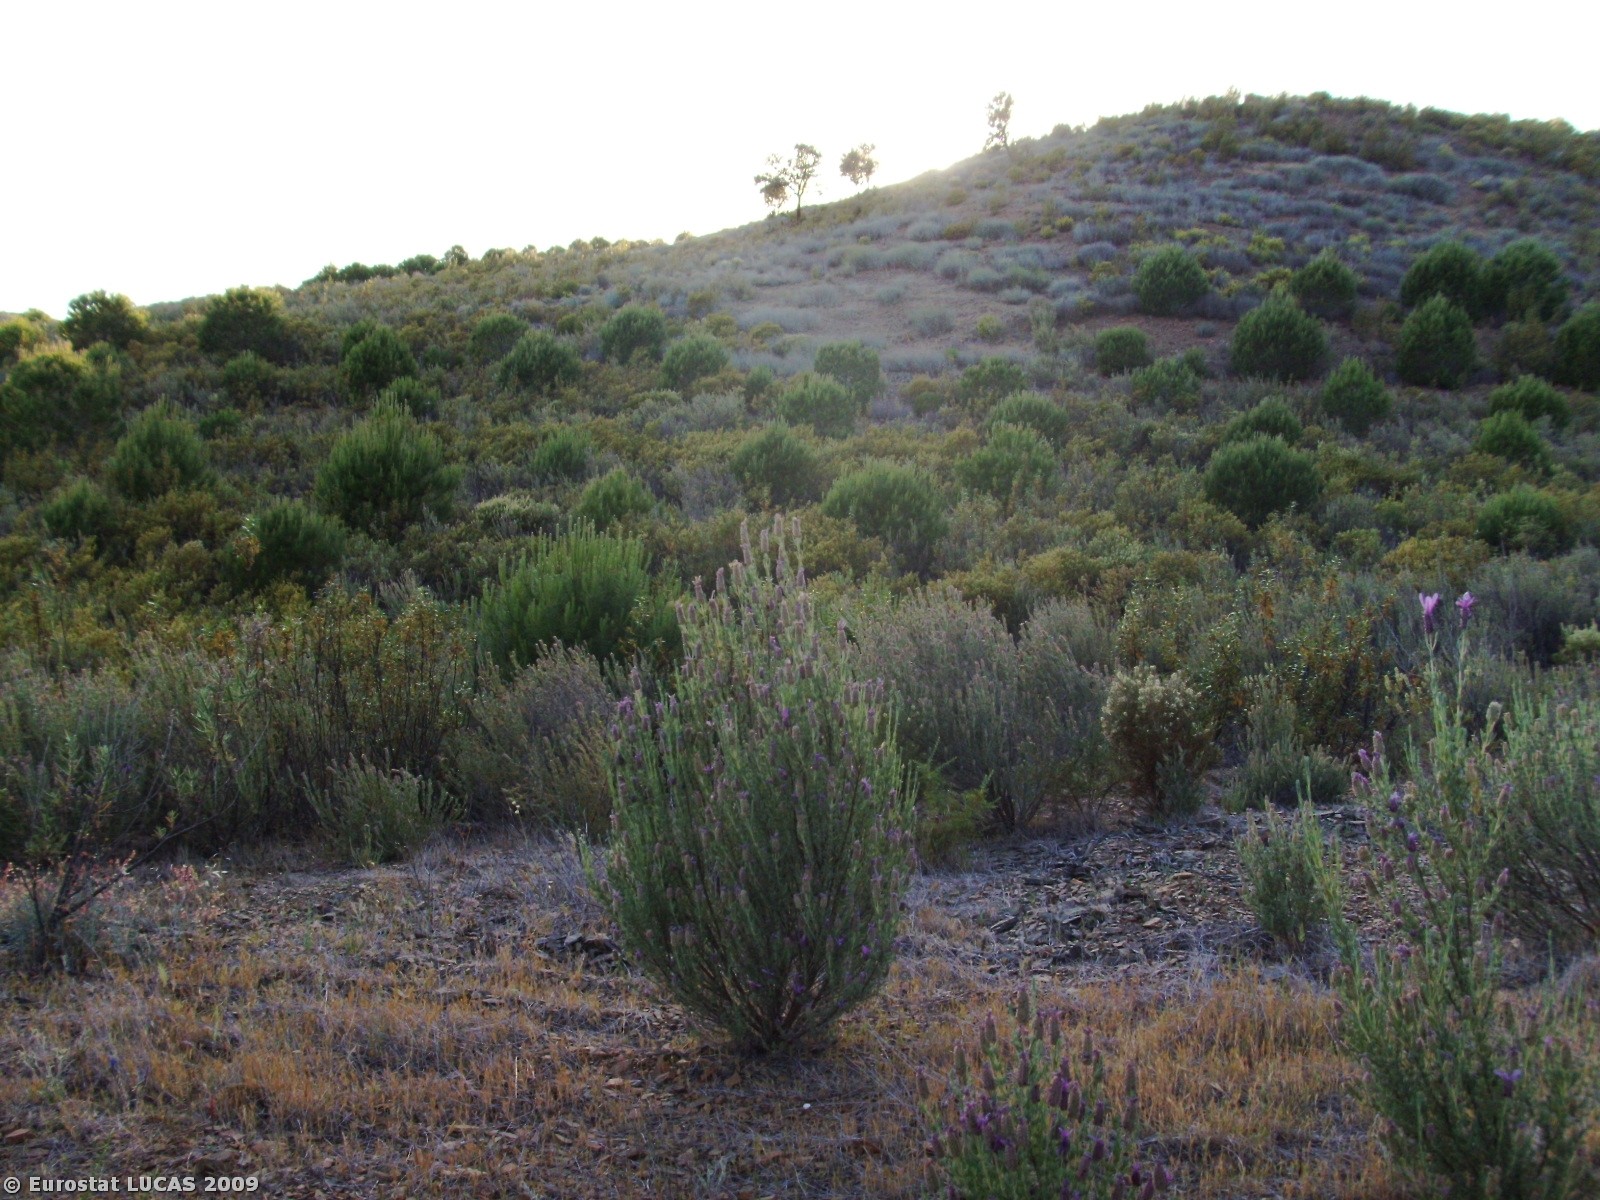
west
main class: Shrubland
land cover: Shrubland with sparse tree cover
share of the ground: < 10 %
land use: Forestry
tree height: > 5 m
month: May
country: PT
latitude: 37.3568
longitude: -7.5636
